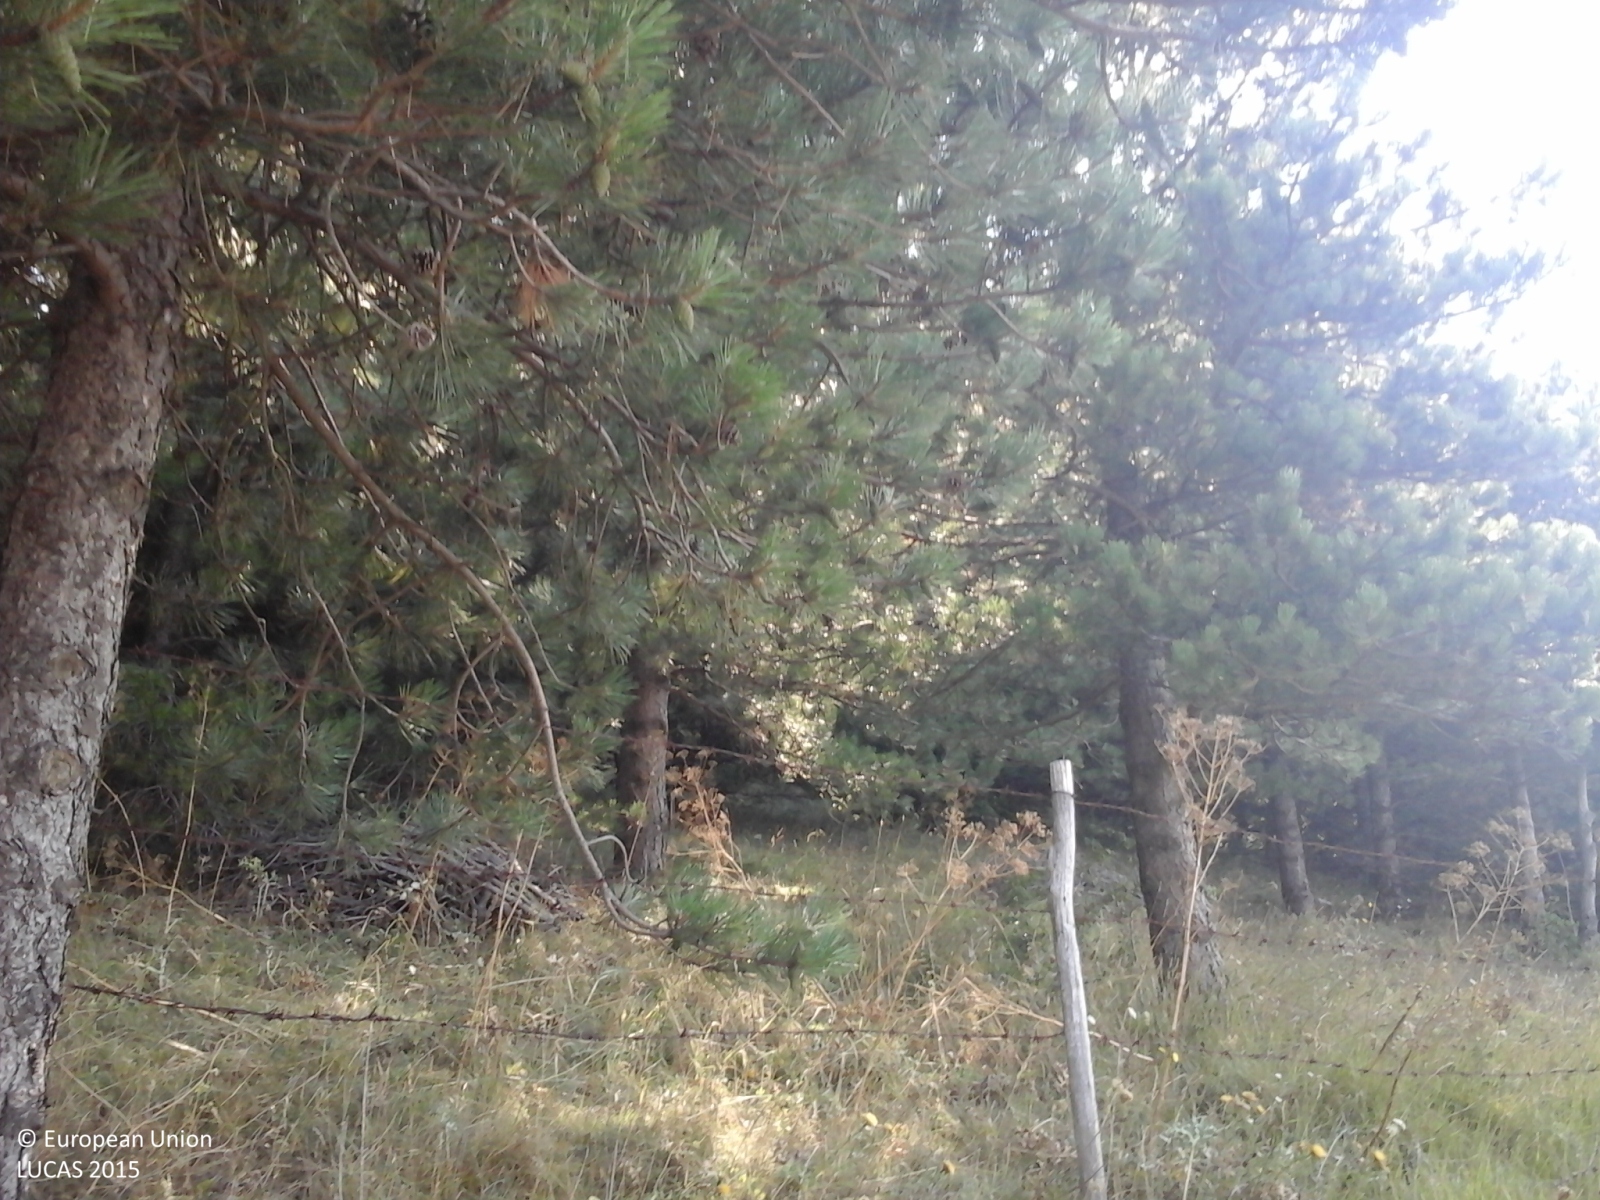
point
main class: Woodland
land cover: Pine dominated coniferous woodland
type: coniferous forest of the mediterranean region
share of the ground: > 75 %
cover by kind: coniferous forest trees 95 %, herbaceous plants 5 %
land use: Semi-natural and natural areas not in use
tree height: > 5 m
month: August
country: IT
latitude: 41.3652
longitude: 15.1346
